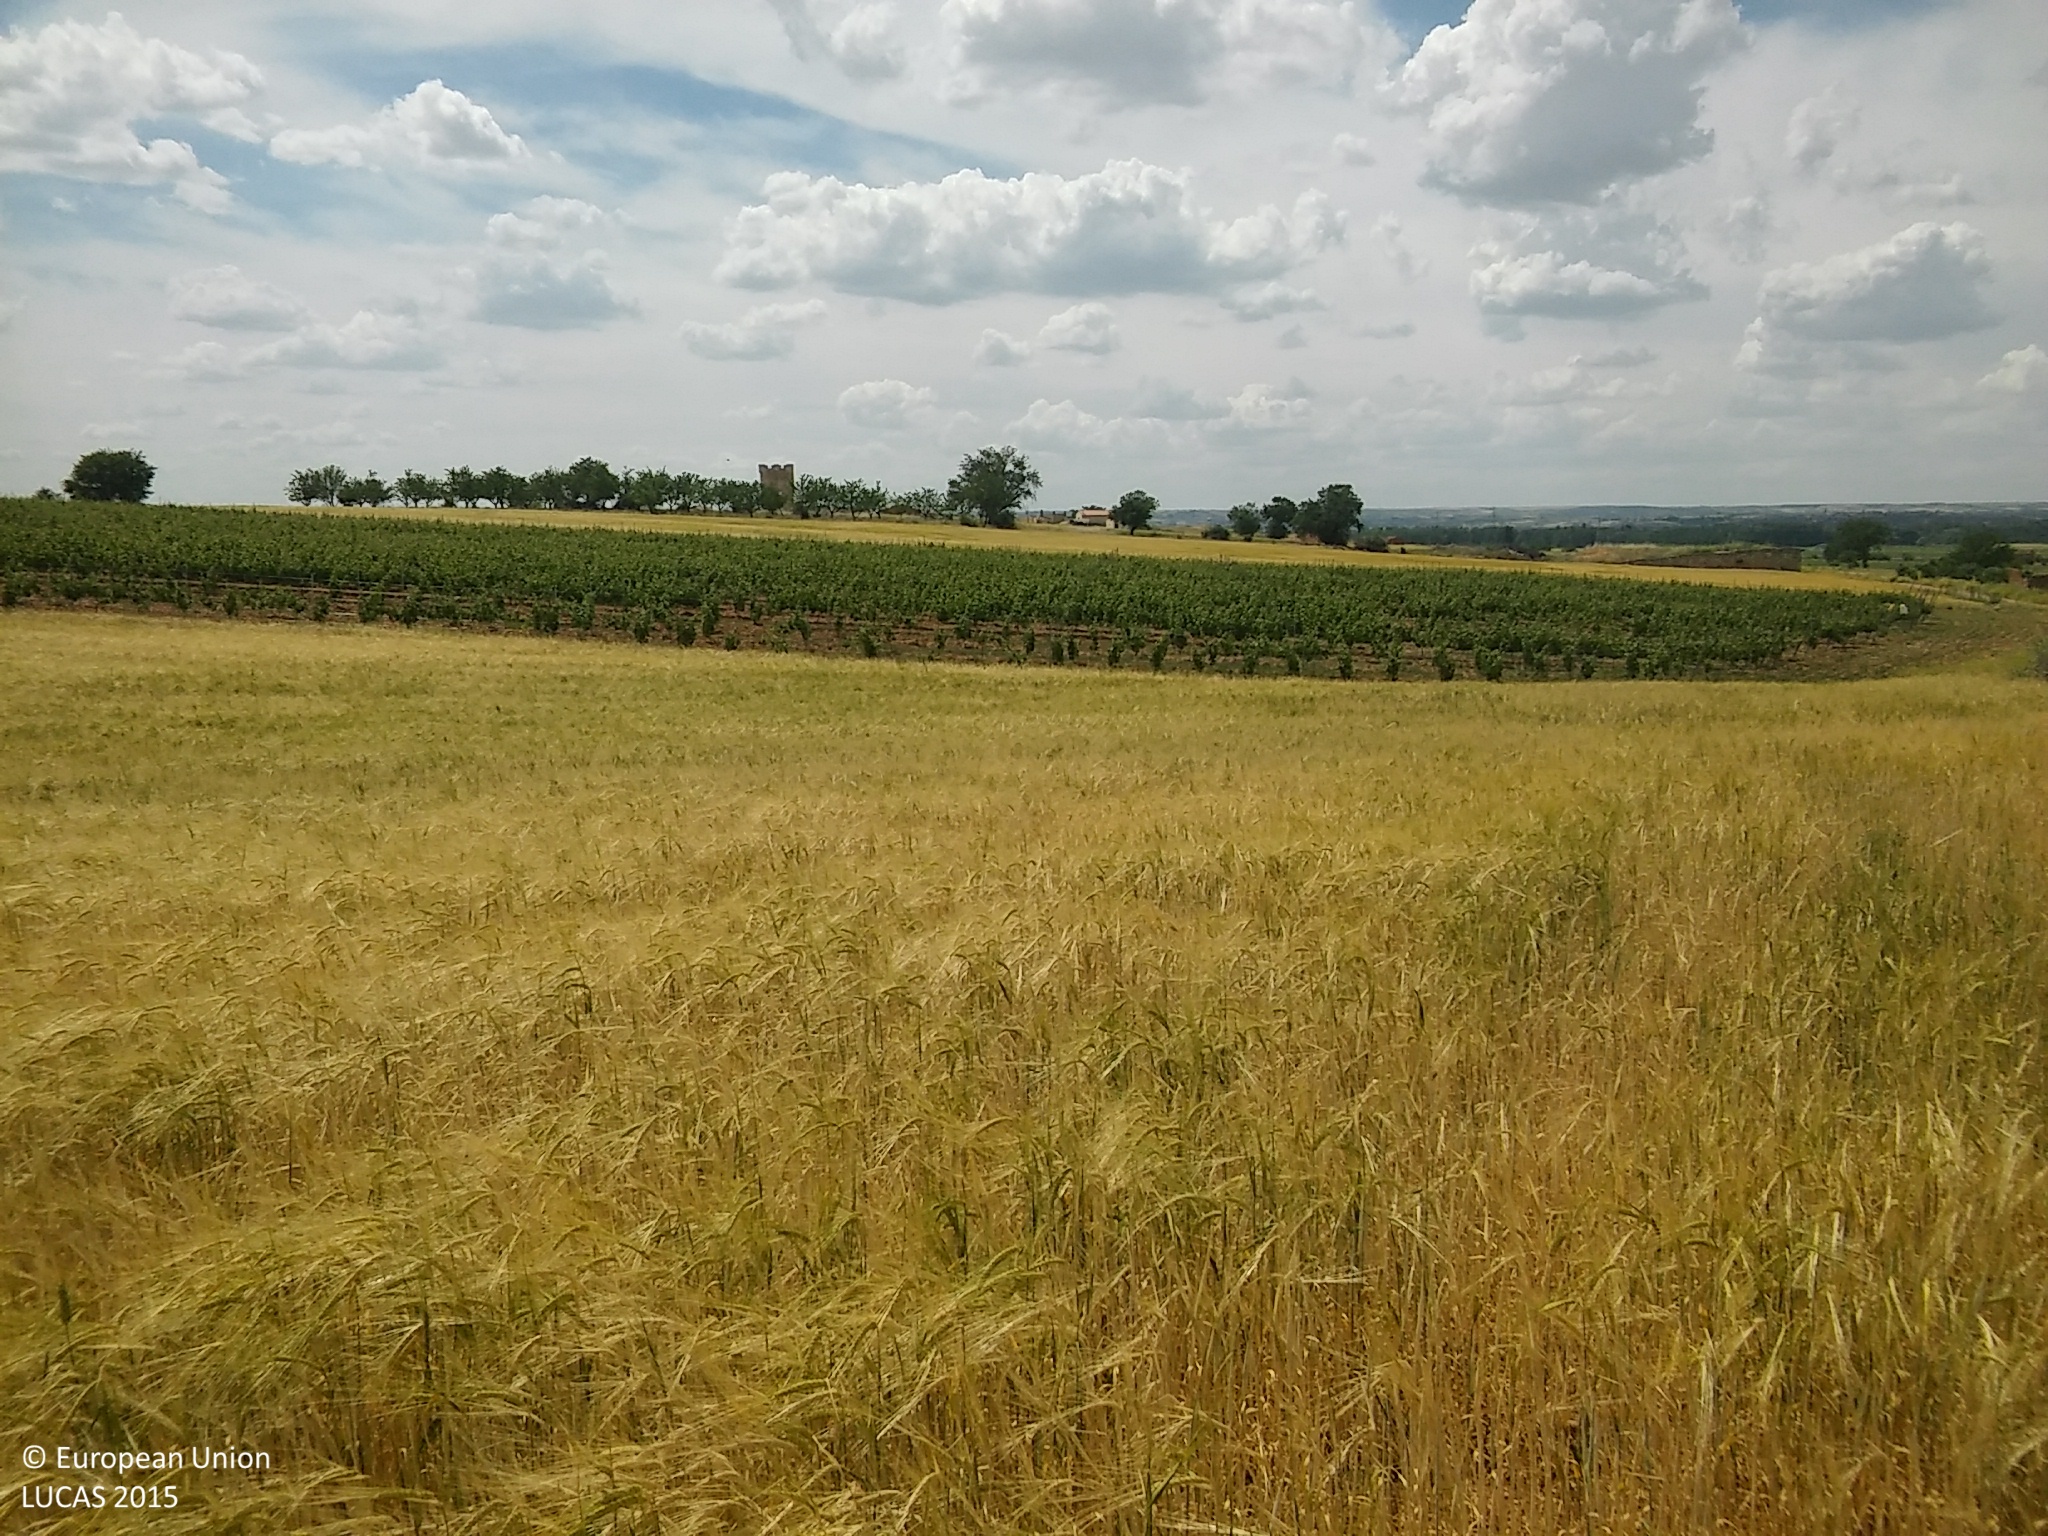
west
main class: Cropland
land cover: Barley
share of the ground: > 75 %
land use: Agriculture (excluding fallow land and kitchen gardens)
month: June
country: ES
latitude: 41.6602
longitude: -3.8536
